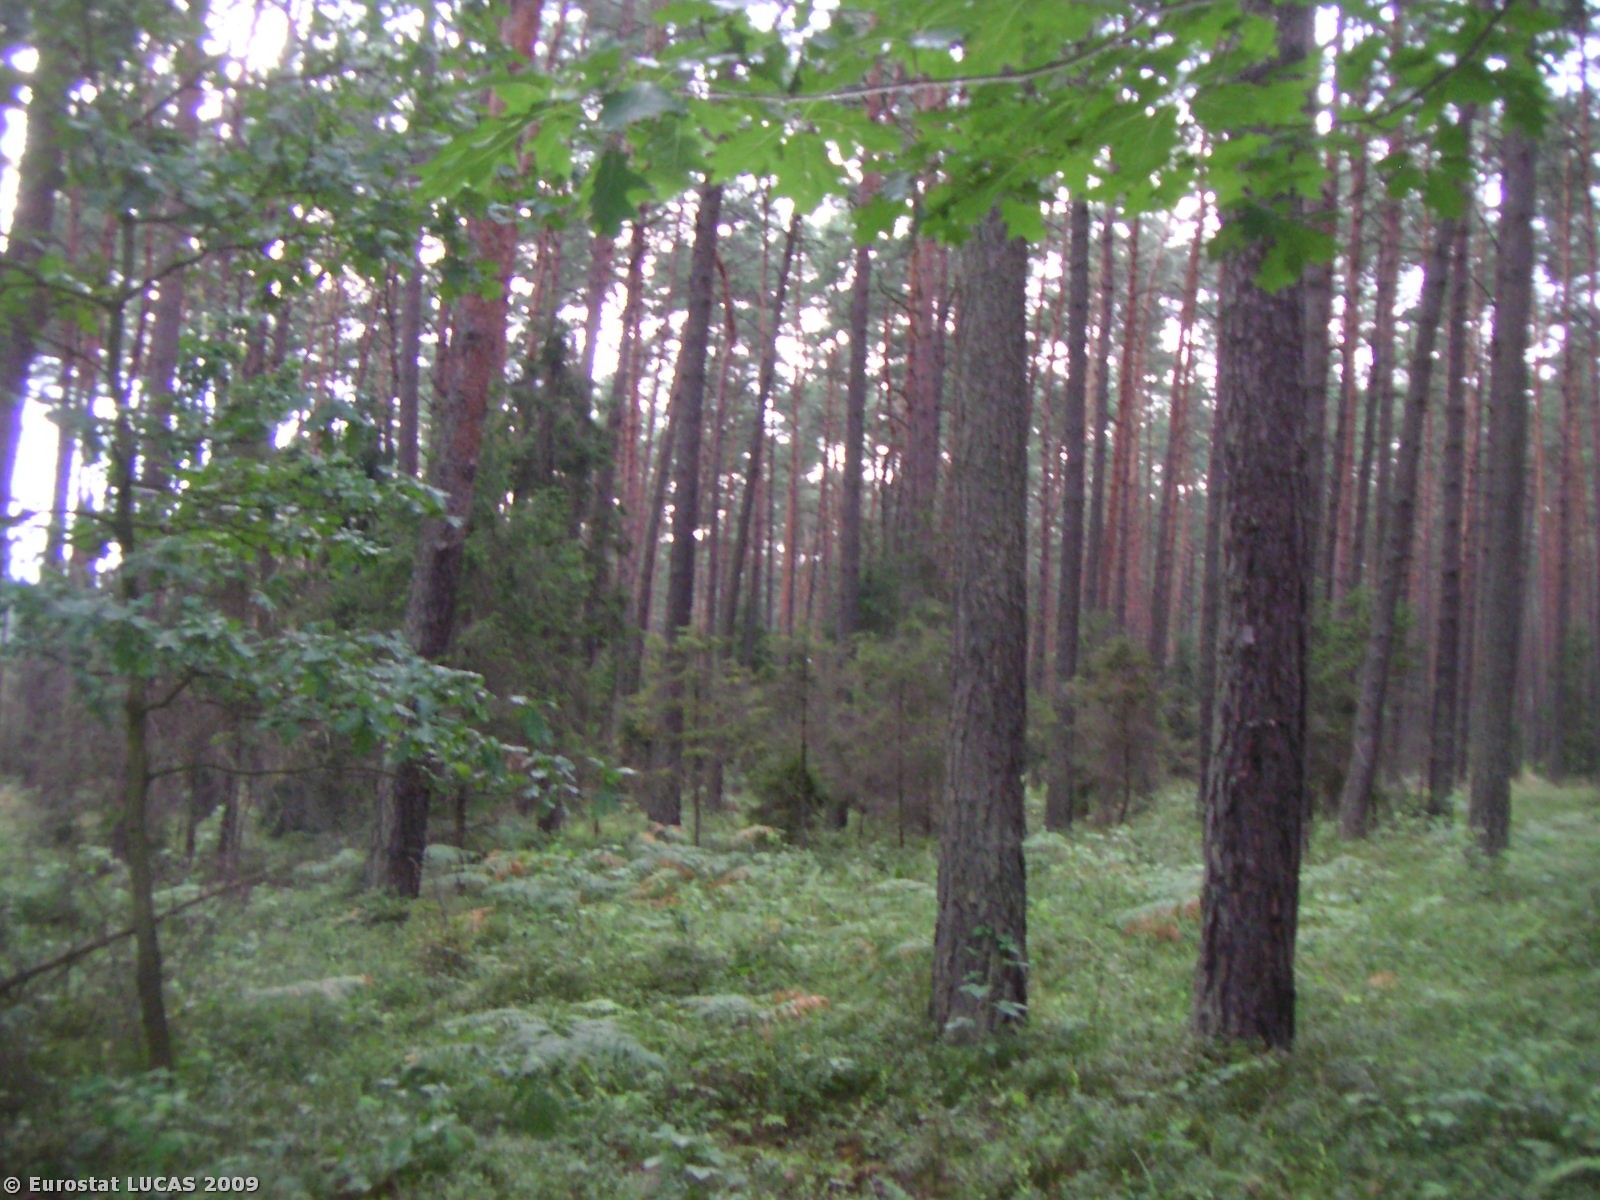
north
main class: Woodland
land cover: Coniferous woodland
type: hemiboreal forest and nemoral coniferous forest and mixed broadleaved-coniferous forest
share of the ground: > 75 %
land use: Forestry
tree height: > 5 m
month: July
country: PL
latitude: 50.7106
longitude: 18.3309
